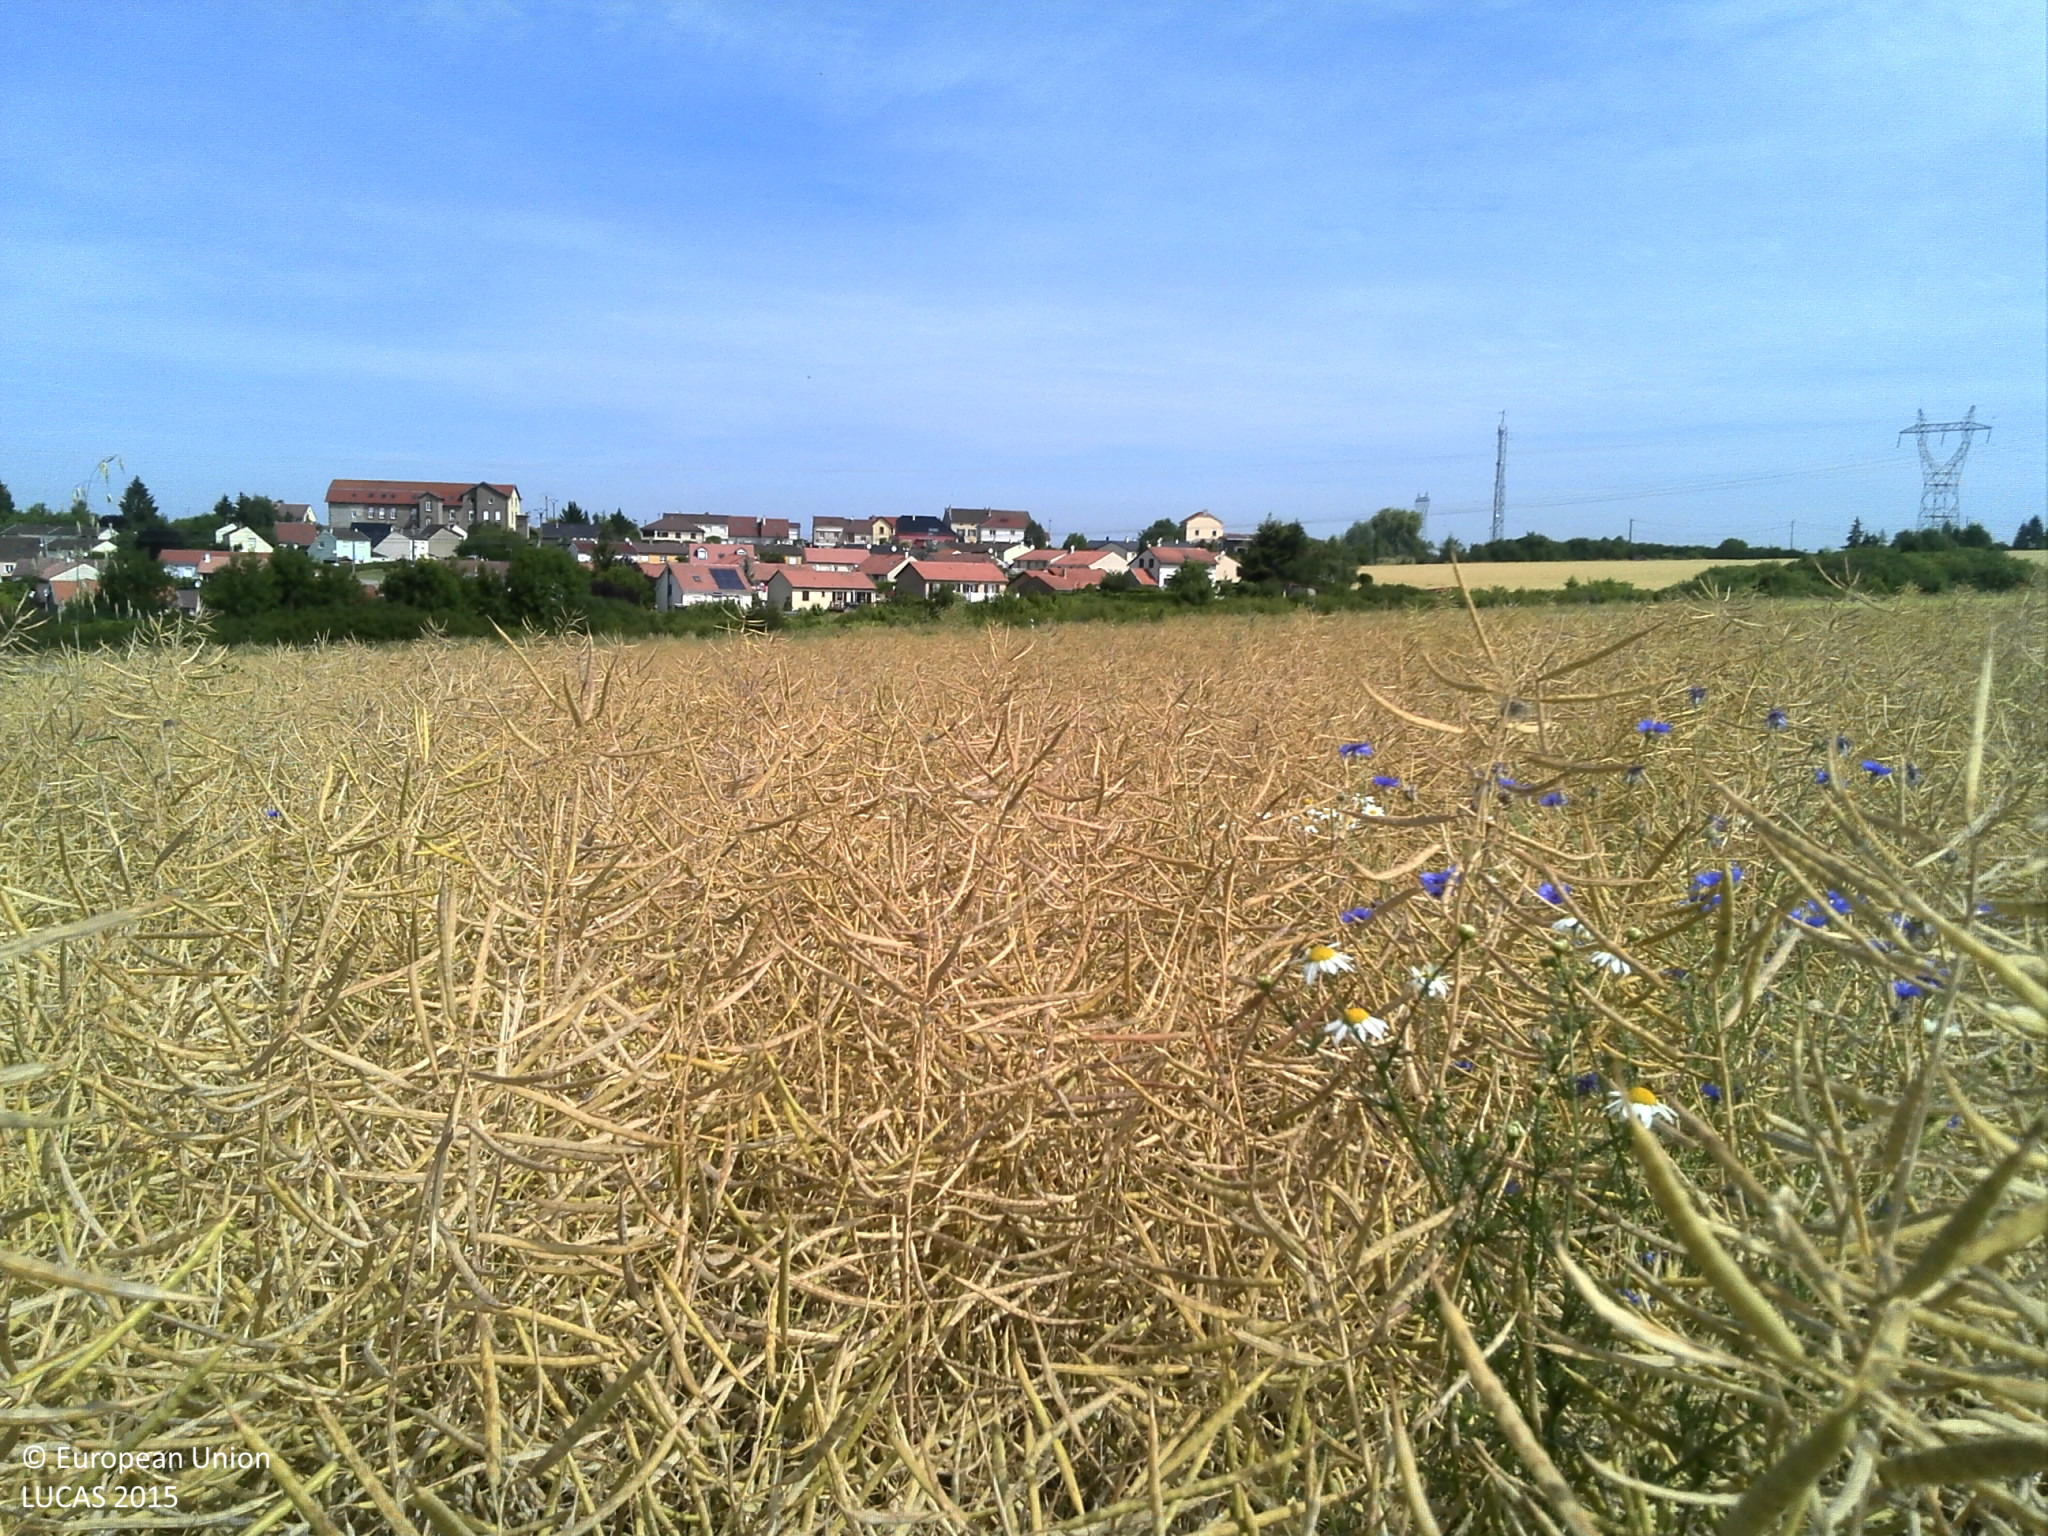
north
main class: Cropland
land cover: Rape and turnip rape
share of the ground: > 75 %
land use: Agriculture (excluding fallow land and kitchen gardens)
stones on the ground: > 50 %
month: June
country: FR
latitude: 49.2149
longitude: 6.0320
